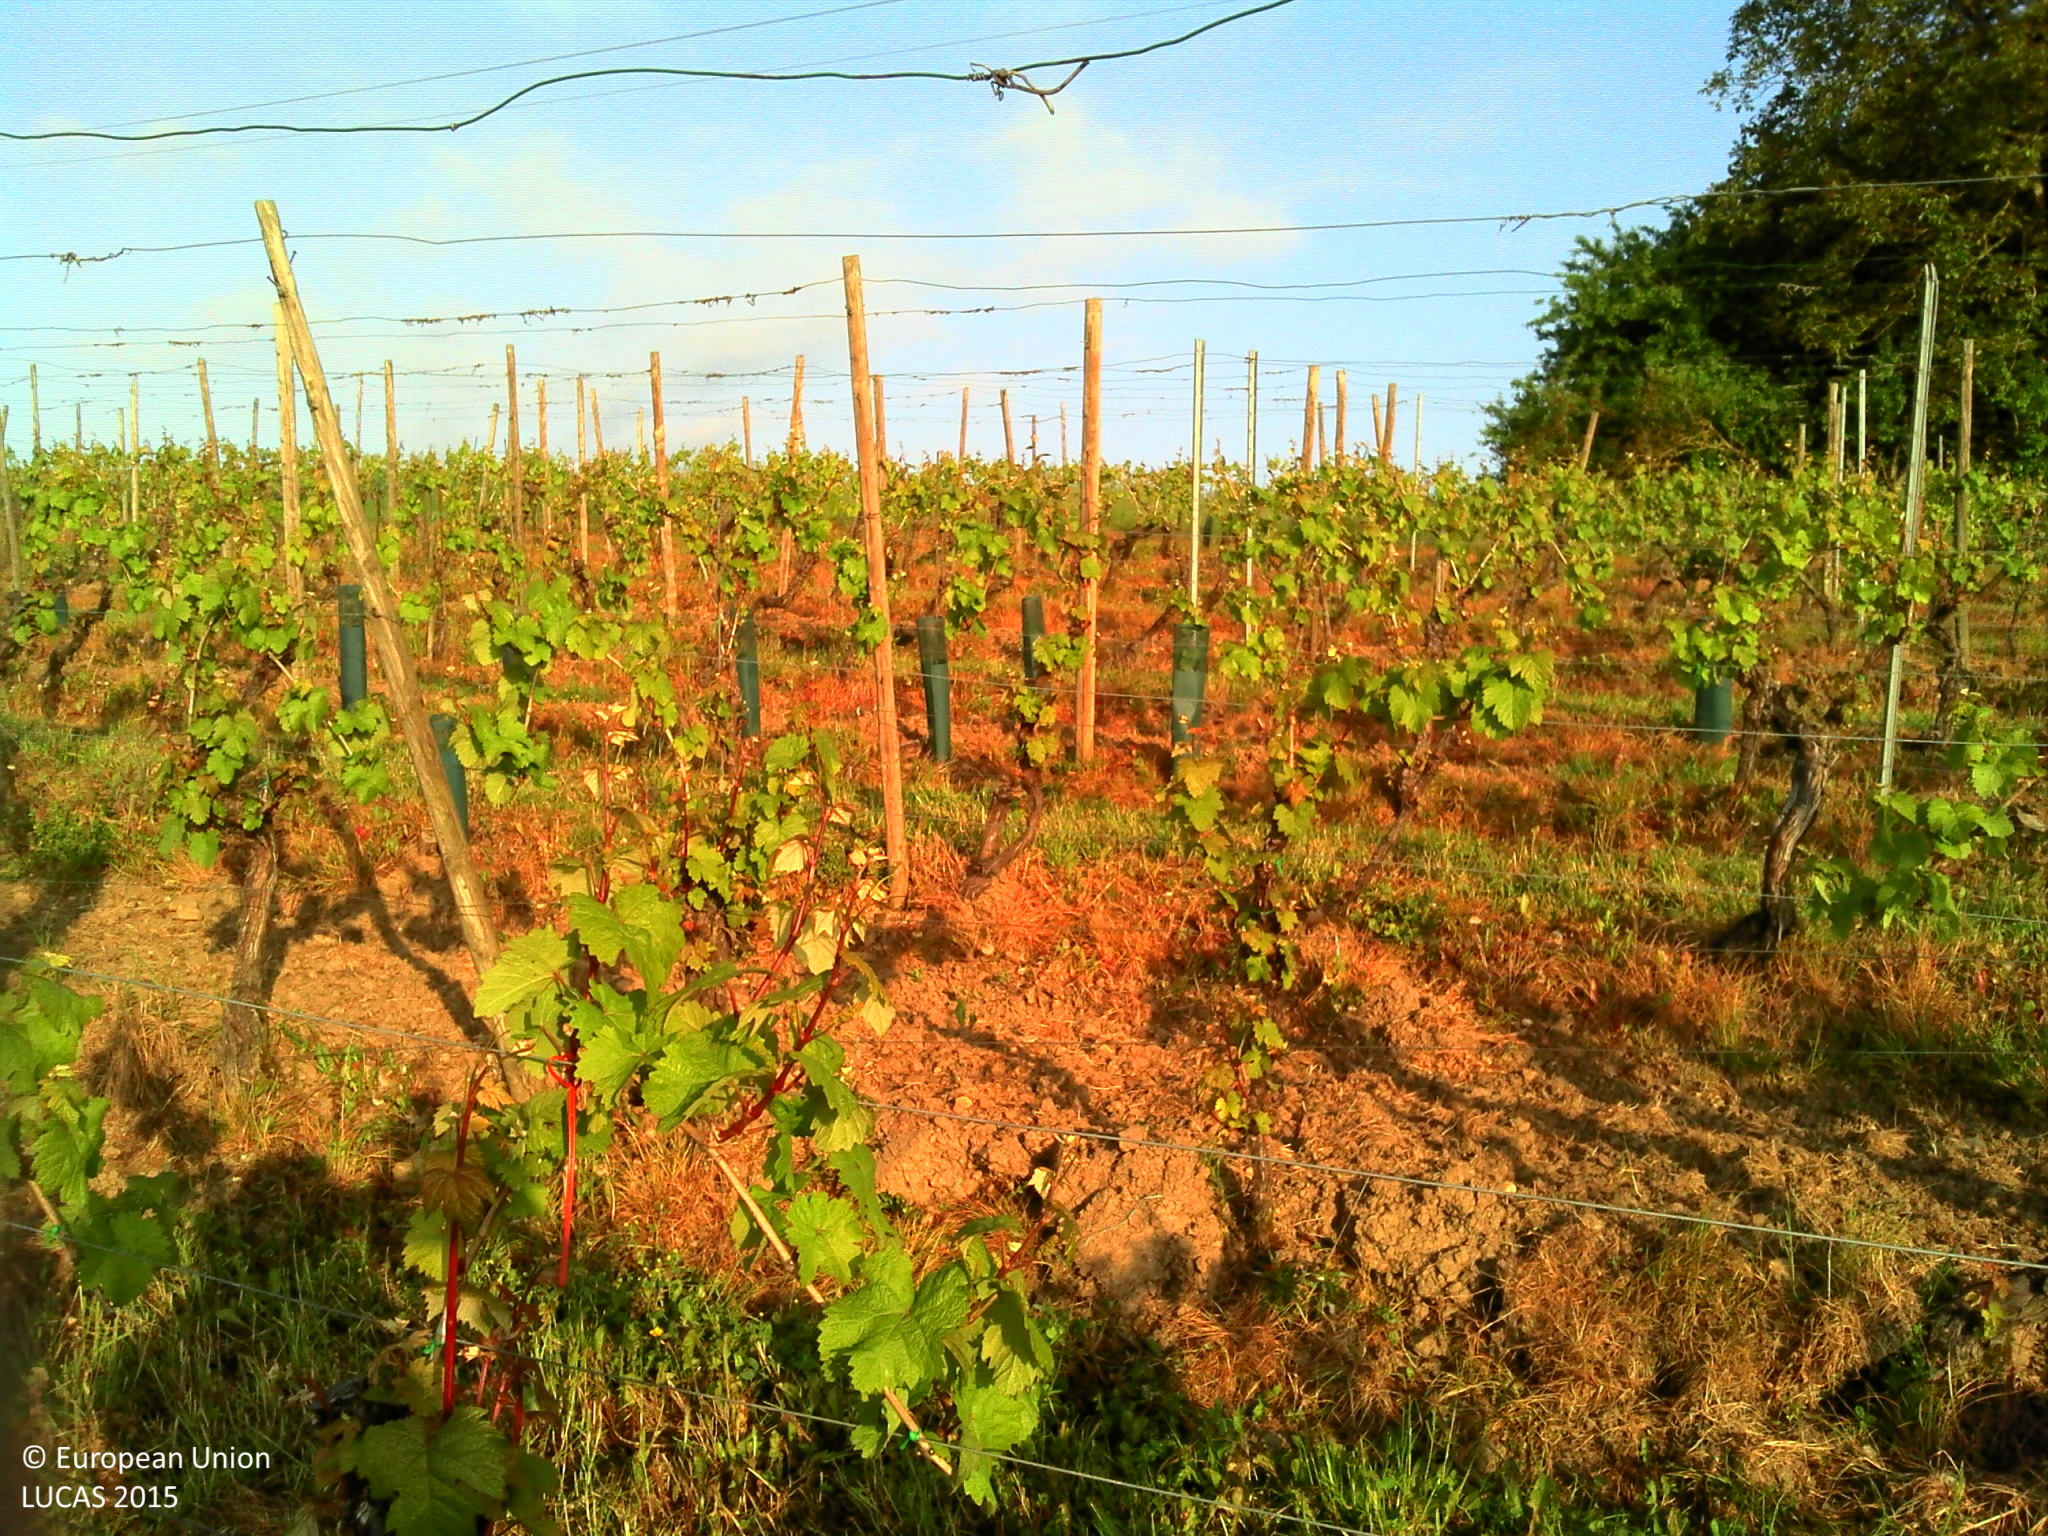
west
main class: Cropland
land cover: Vineyards
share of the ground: > 75 %
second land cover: Spontaneously vegetated surfaces
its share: 50 - 75 %
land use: Agriculture (excluding fallow land and kitchen gardens)
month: May
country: LU
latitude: 49.6239
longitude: 6.4144
